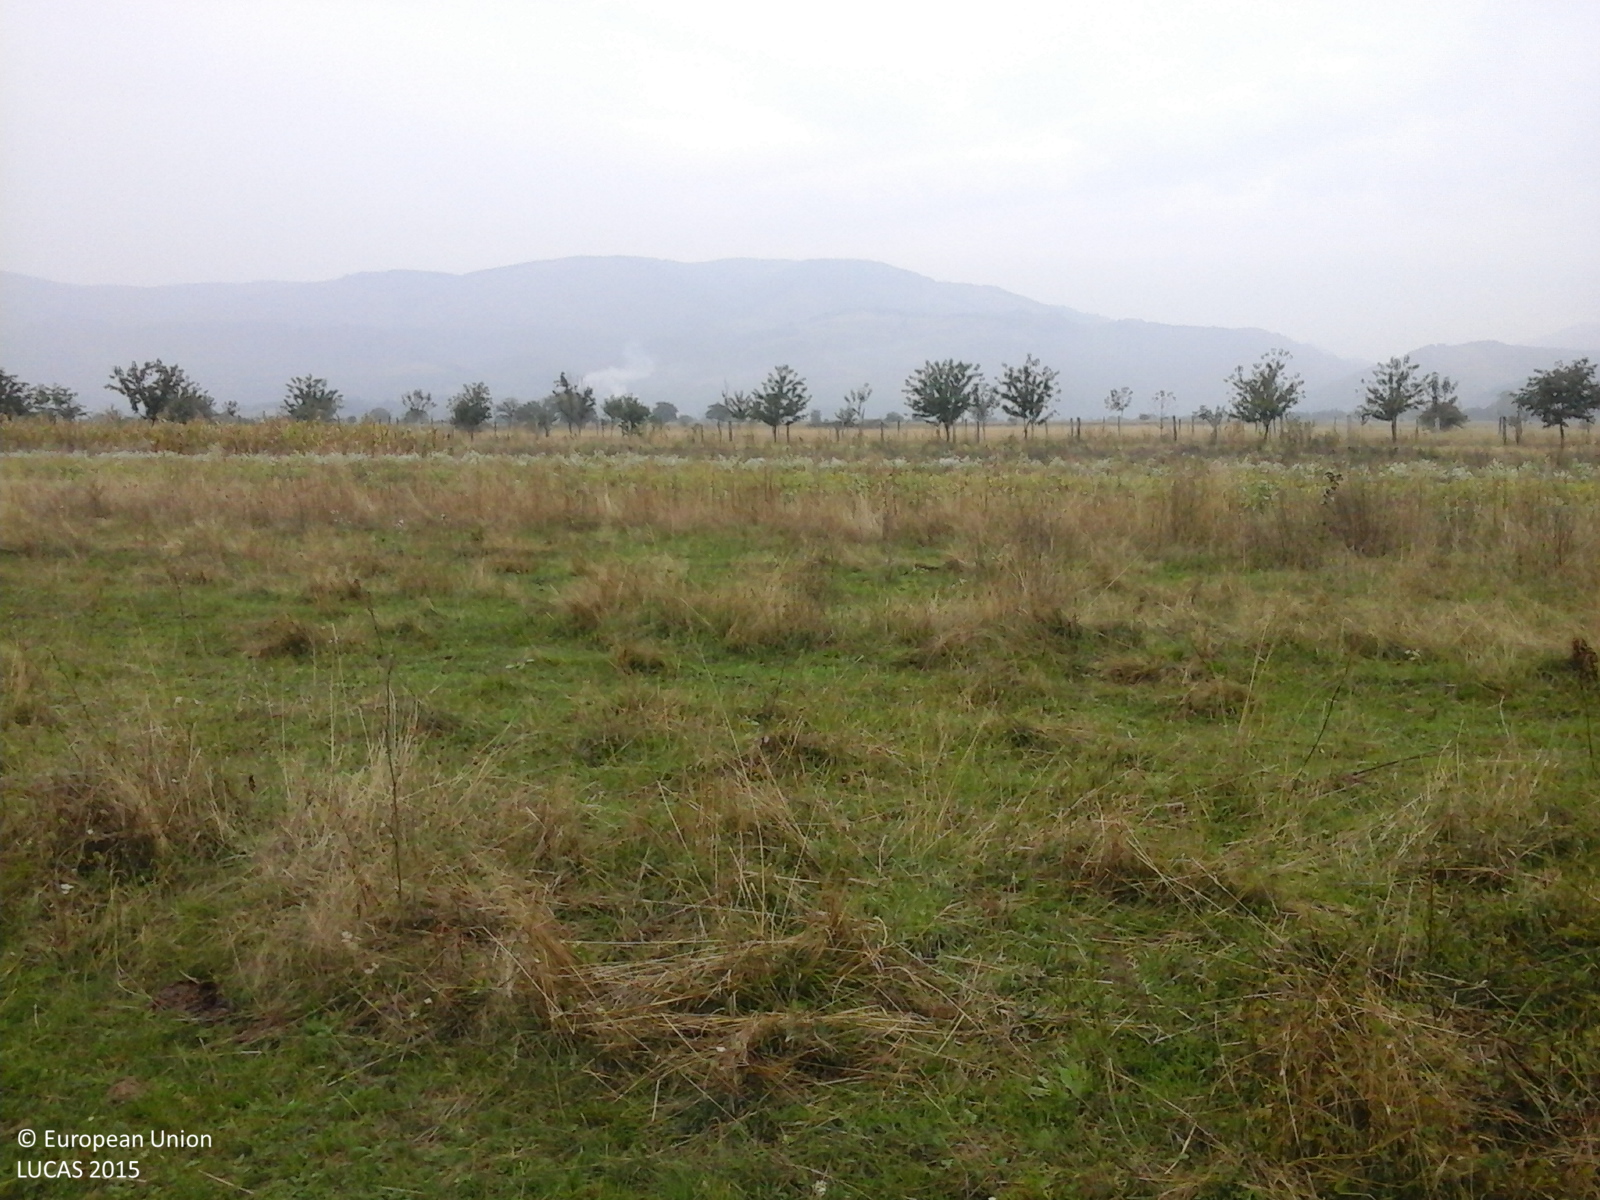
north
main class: Grassland
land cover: Grassland without tree/shrub cover
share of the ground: > 75 %
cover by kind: herbaceous plants 100 %
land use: Agriculture (excluding fallow land and kitchen gardens)
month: September
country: RO
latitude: 45.1373
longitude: 23.2667
